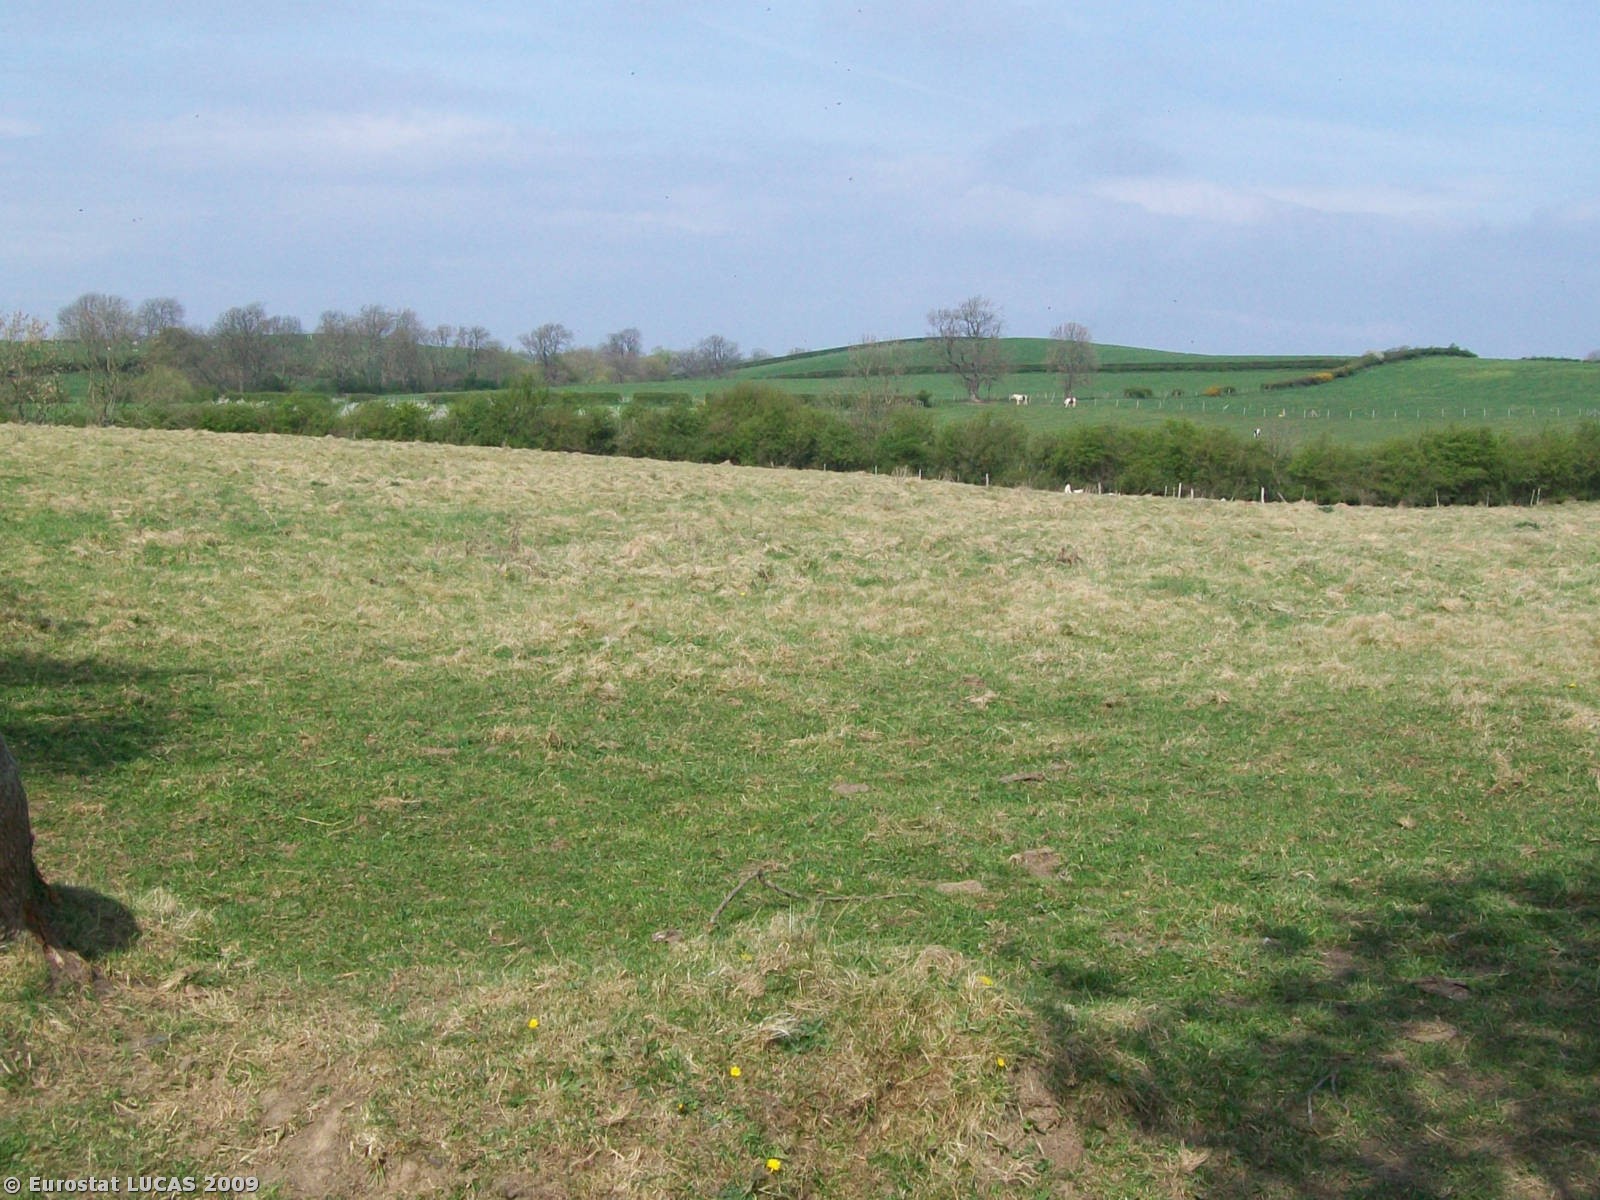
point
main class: Grassland
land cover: Grassland without tree/shrub cover
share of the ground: > 75 %
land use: Agriculture (excluding fallow land and kitchen gardens)
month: April
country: GB
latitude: 54.6528
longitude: -1.2821
